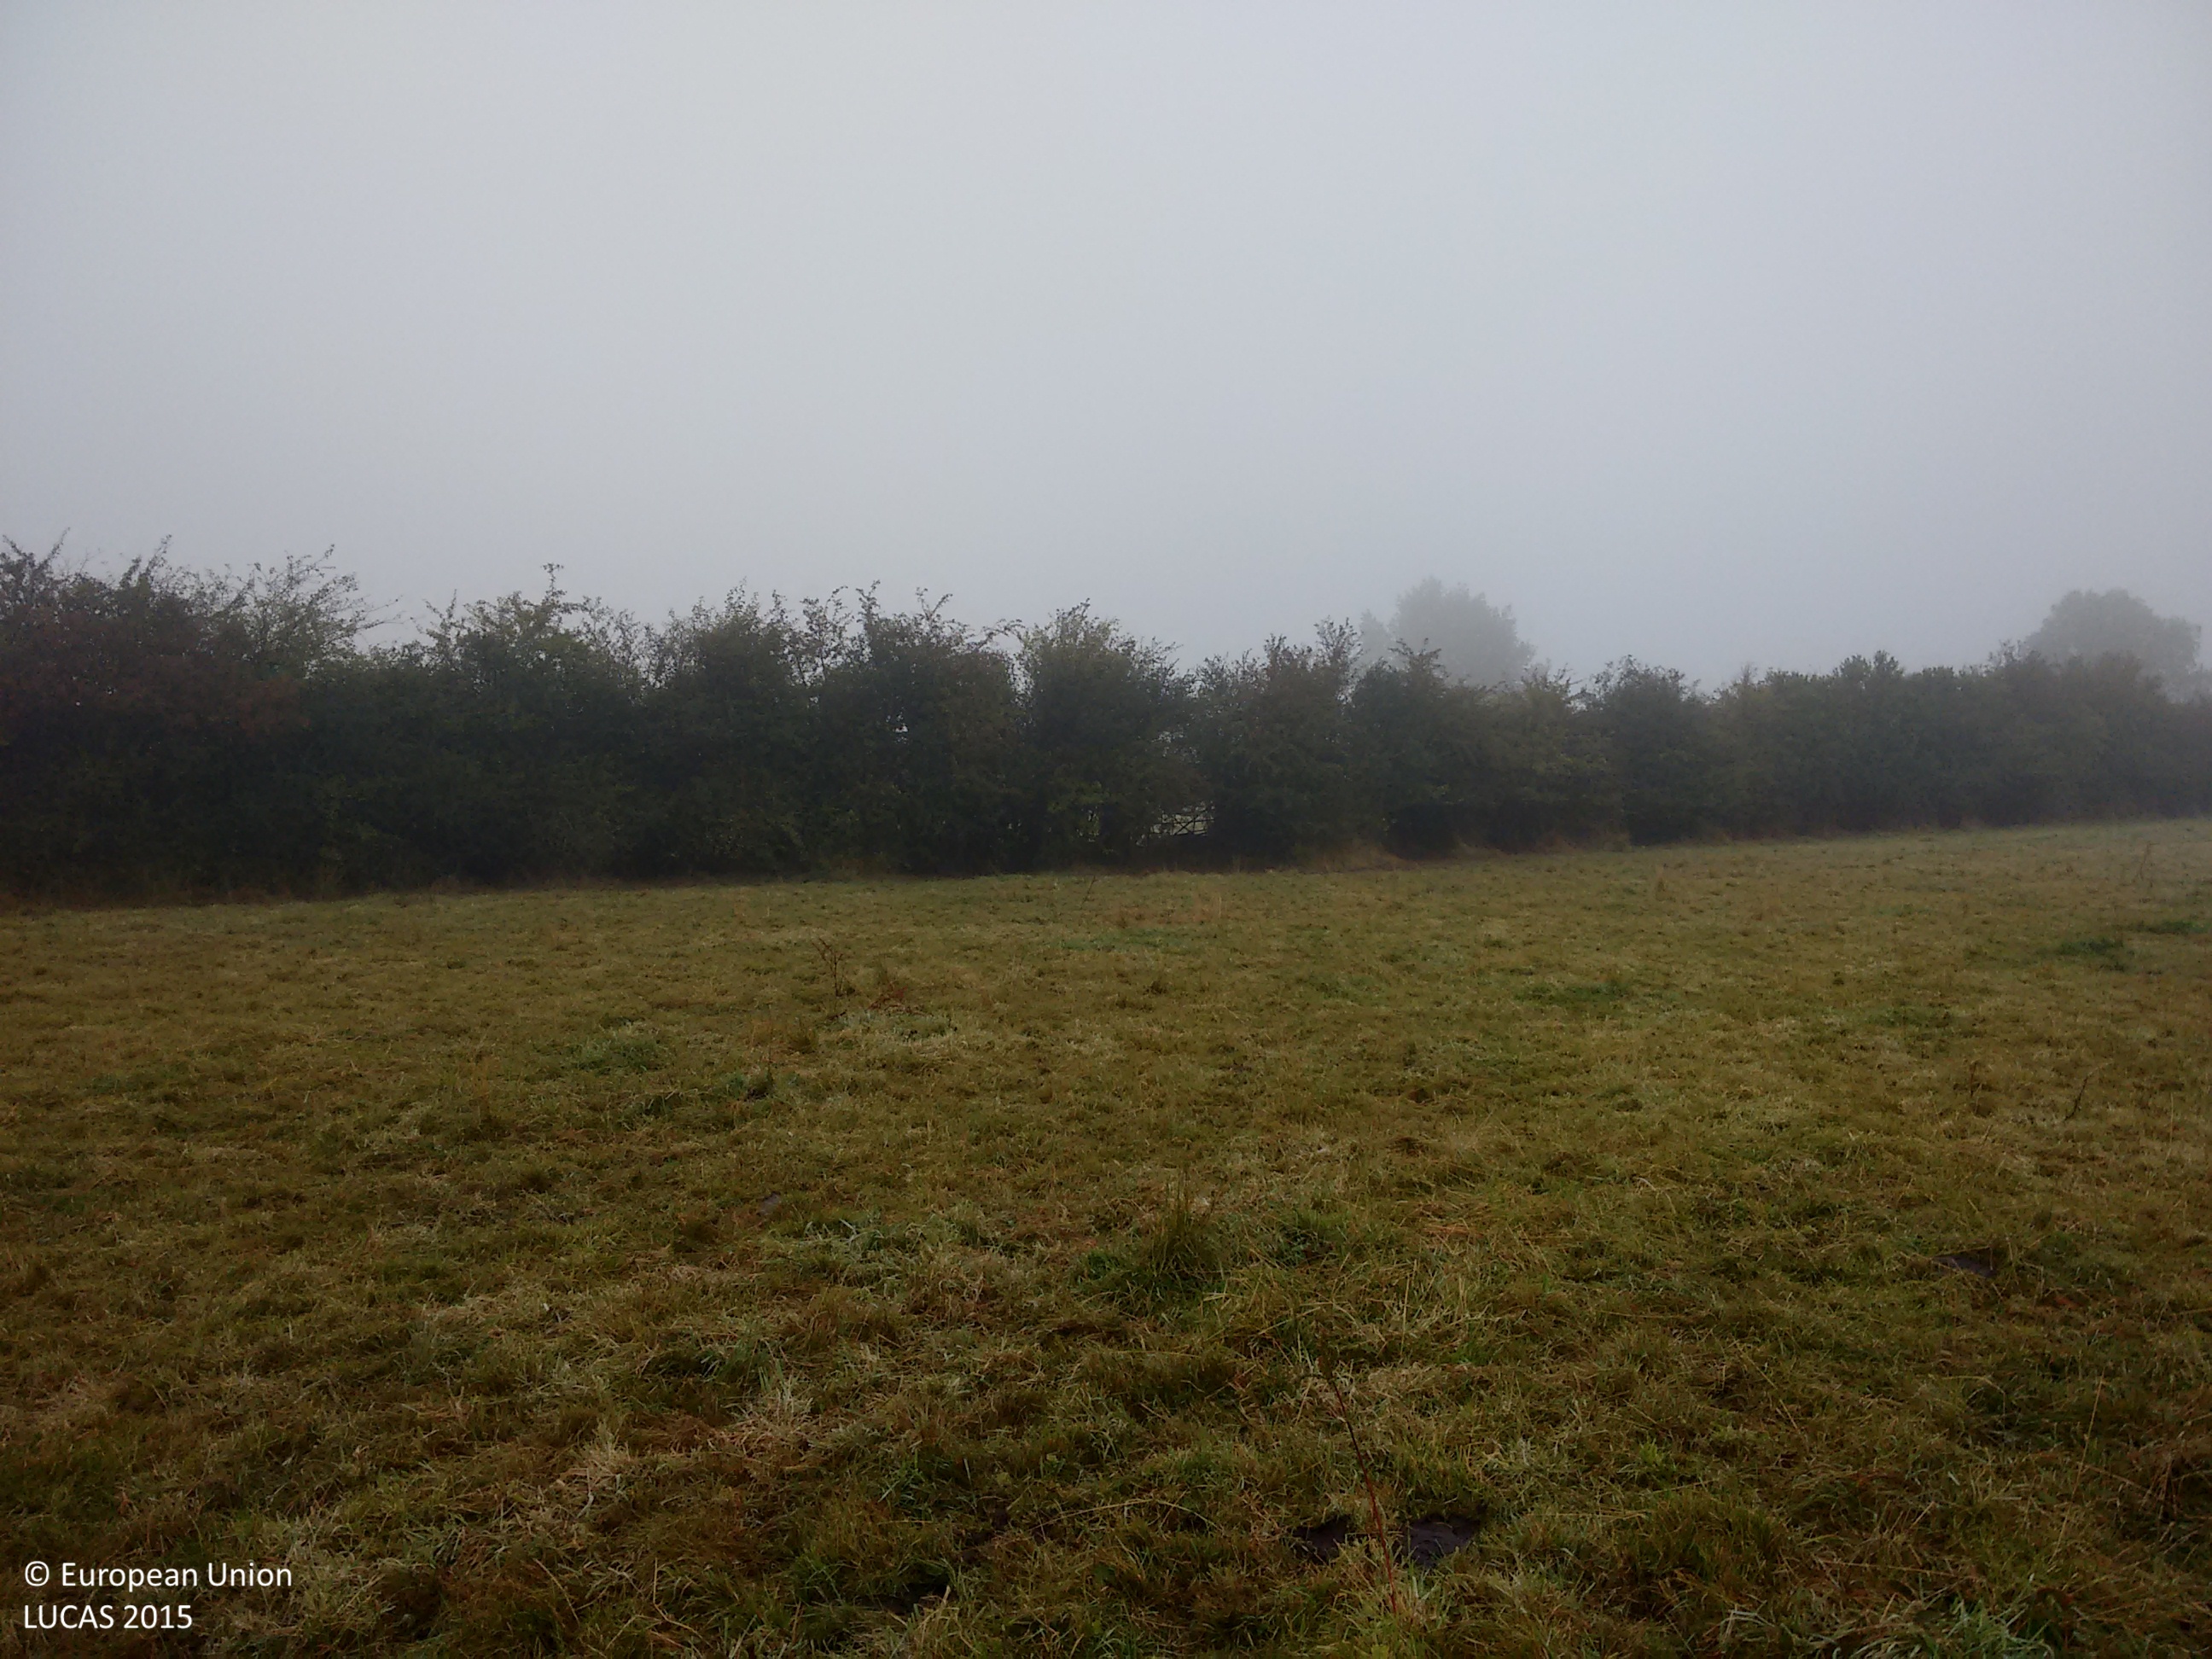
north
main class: Grassland
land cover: Grassland without tree/shrub cover
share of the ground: > 75 %
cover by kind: herbaceous plants 100 %
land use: Agriculture (excluding fallow land and kitchen gardens)
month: October
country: IE
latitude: 52.4448
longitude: -9.0314
